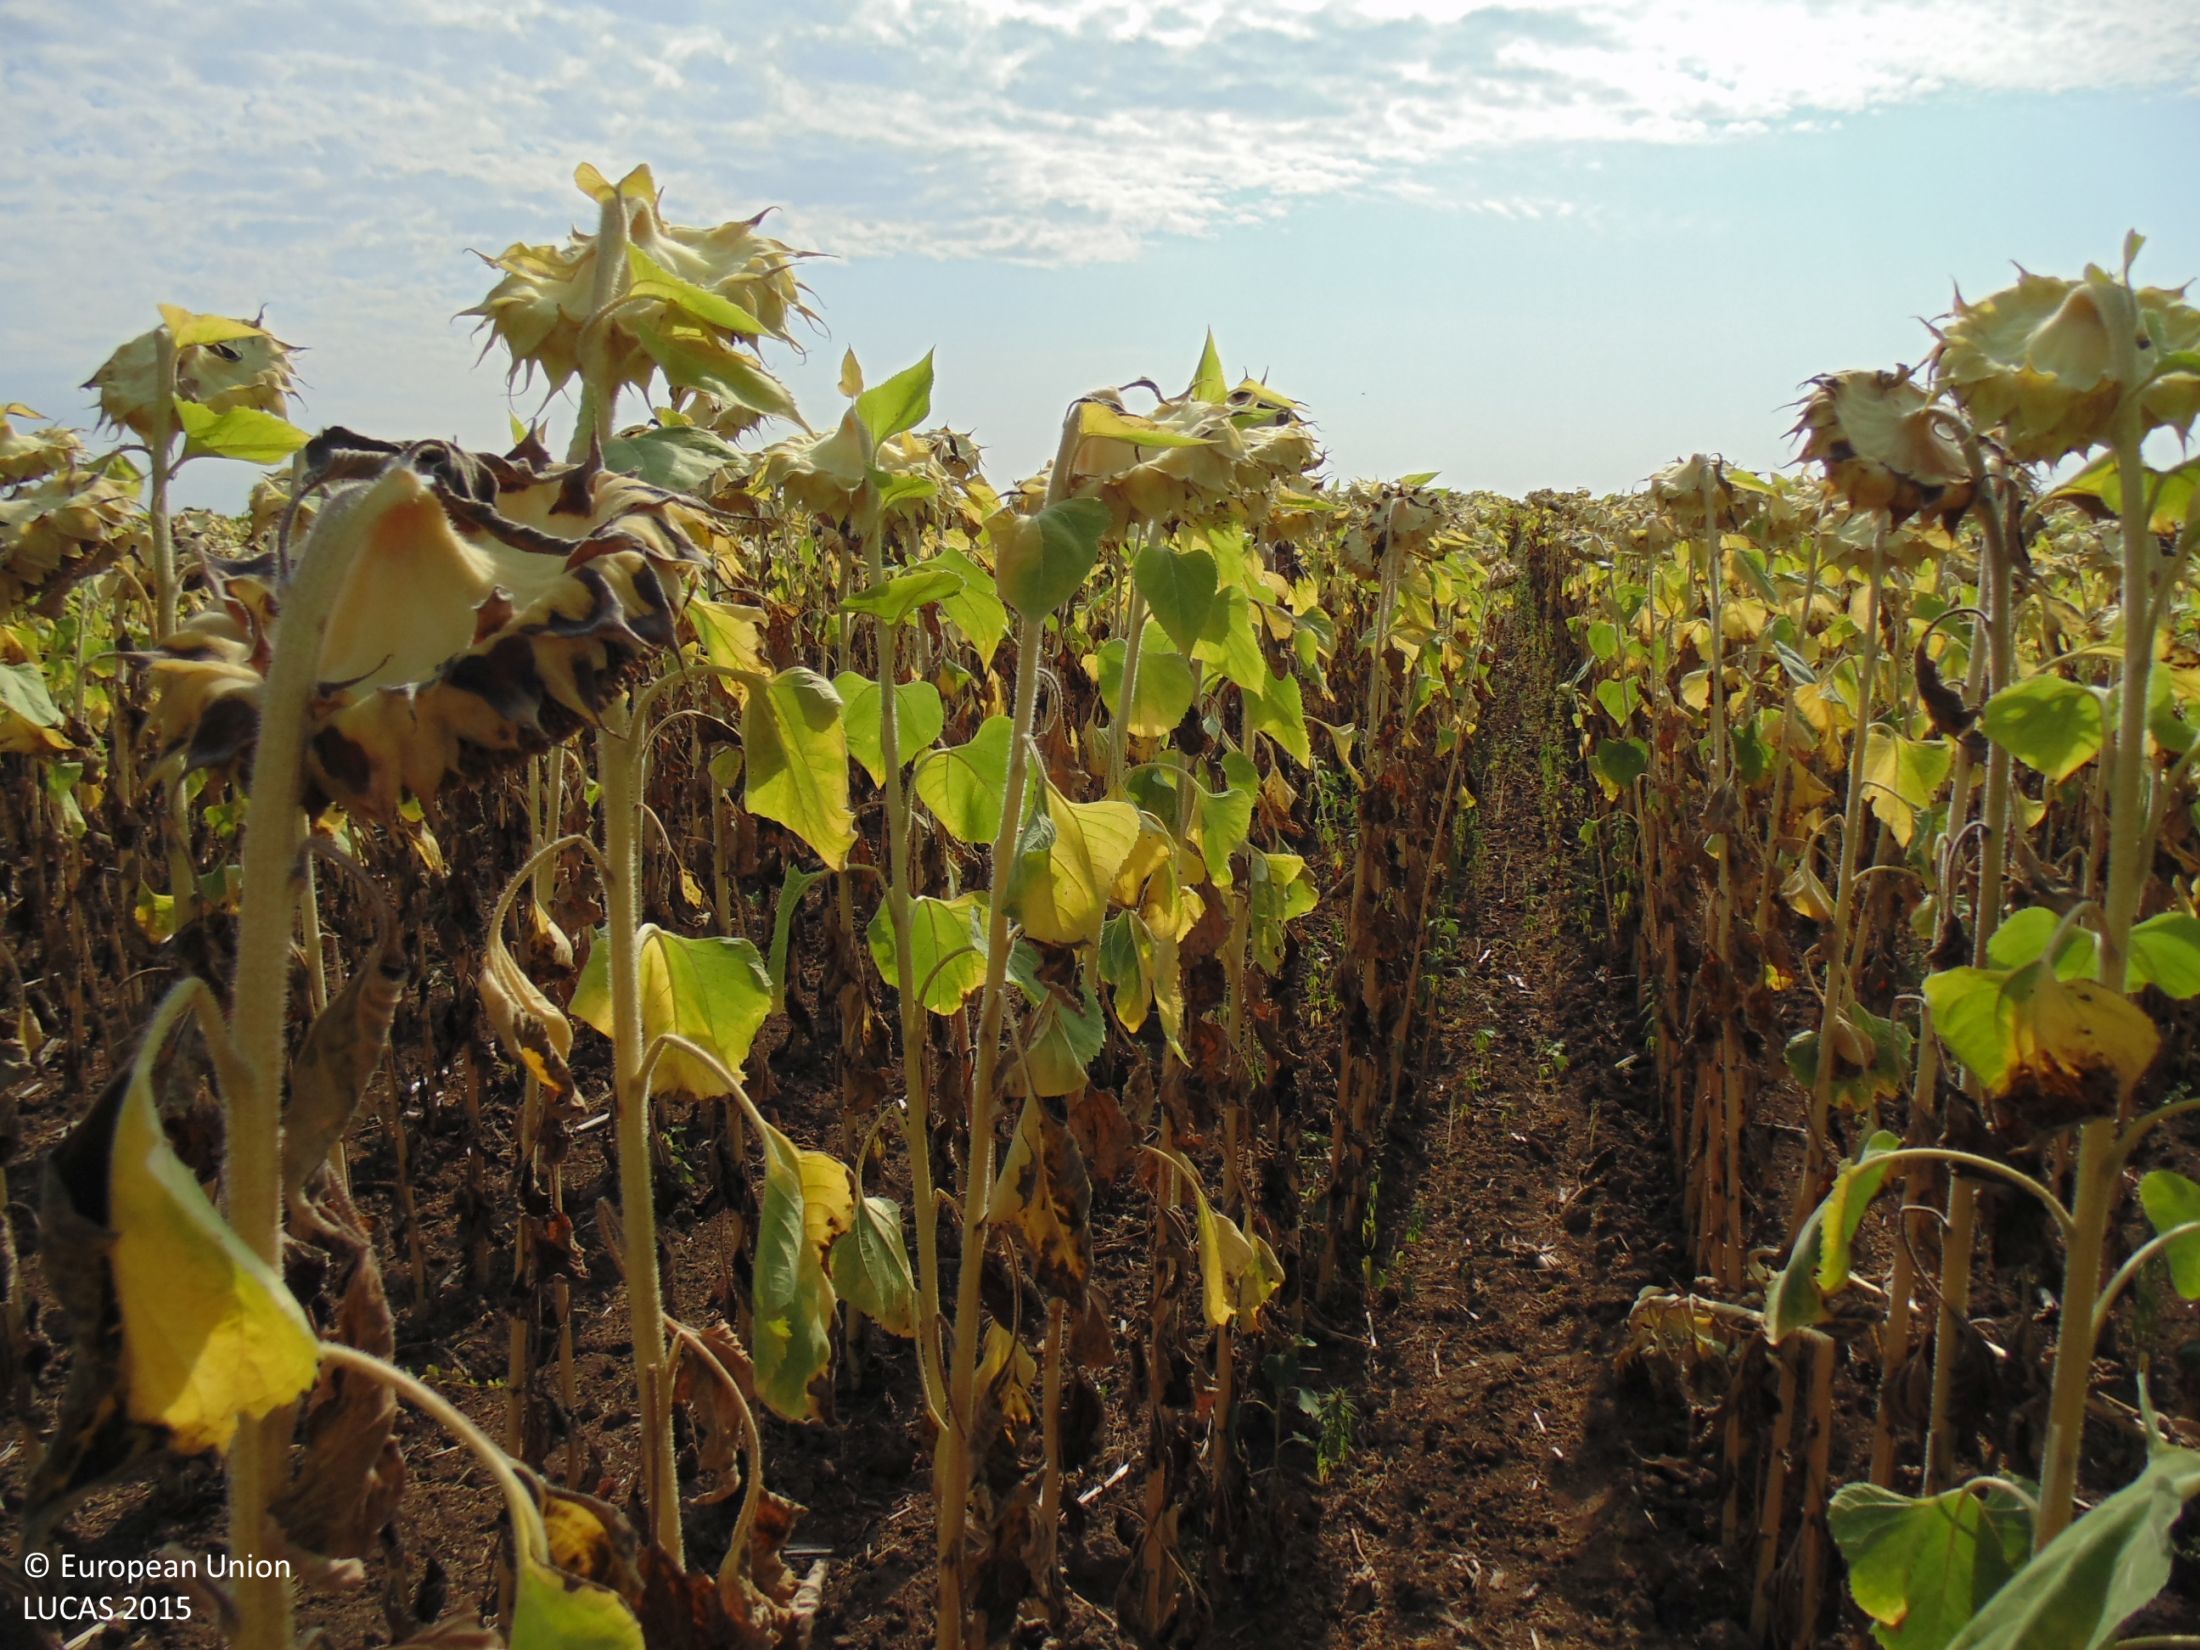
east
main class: Cropland
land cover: Sunflower
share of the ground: > 75 %
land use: Agriculture (excluding fallow land and kitchen gardens)
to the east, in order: Sunflower
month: August
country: BG
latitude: 43.7253
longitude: 27.6540
